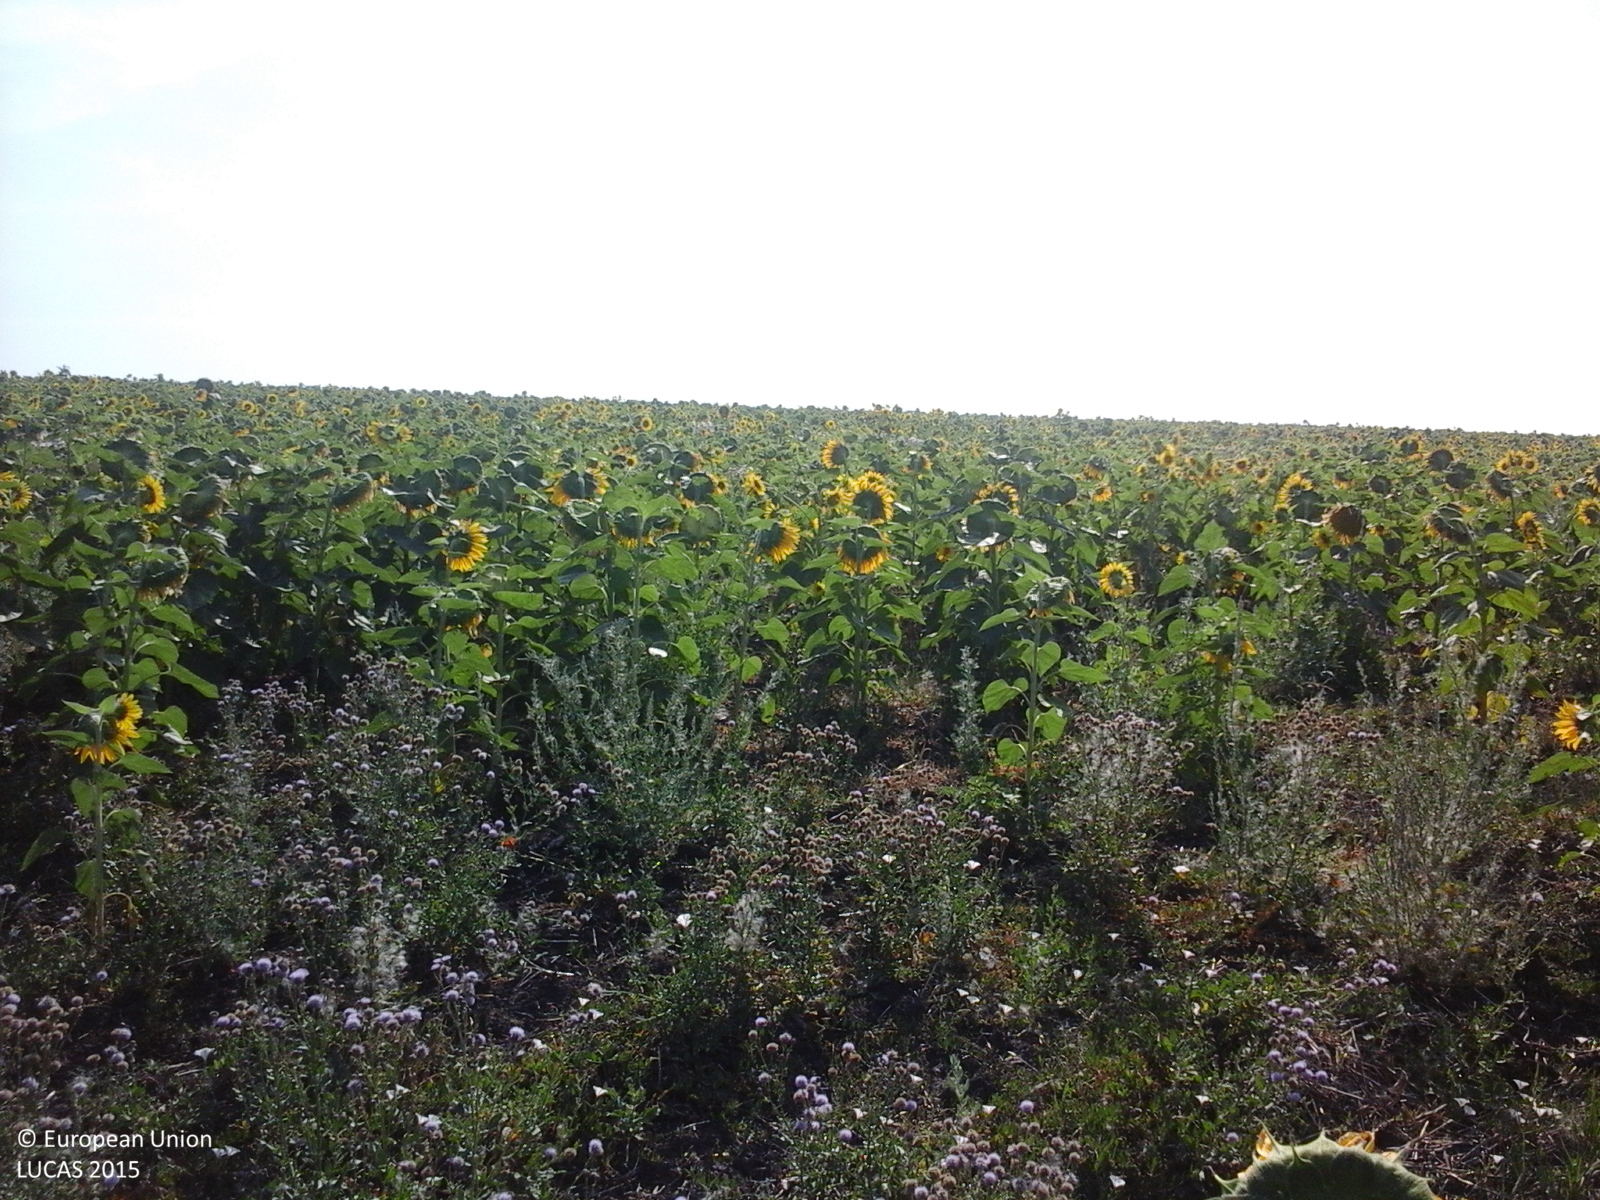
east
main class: Cropland
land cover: Sunflower
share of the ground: > 75 %
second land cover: Spontaneously vegetated surfaces
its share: 50 - 75 %
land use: Agriculture (excluding fallow land and kitchen gardens)
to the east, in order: Sunflower; Spontaneously vegetated surfaces; Grass margins; Tracks; Grass margins; Sunflower
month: July
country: RO
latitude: 46.2529
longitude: 28.0663
